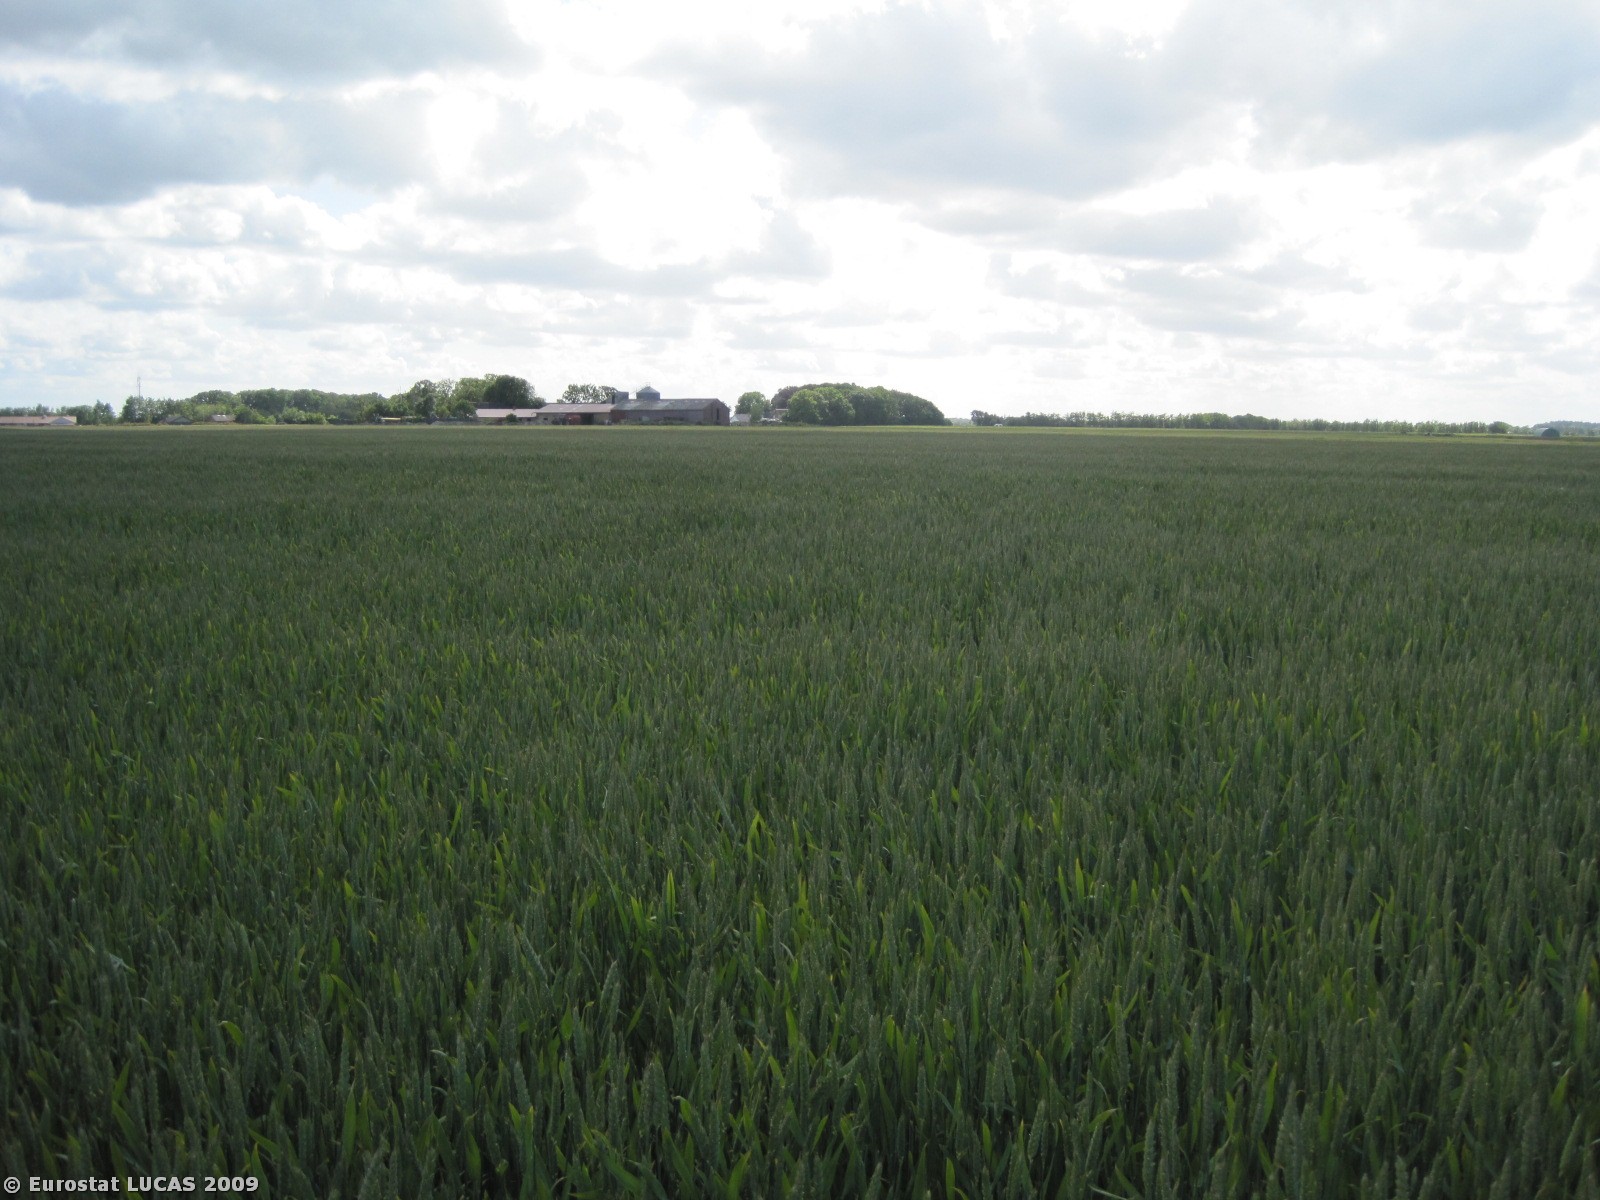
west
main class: Cropland
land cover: Common wheat
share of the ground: > 75 %
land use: Agriculture (excluding fallow land and kitchen gardens)
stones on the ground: < 10 %
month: June
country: DK
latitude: 57.1581
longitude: 9.6864
